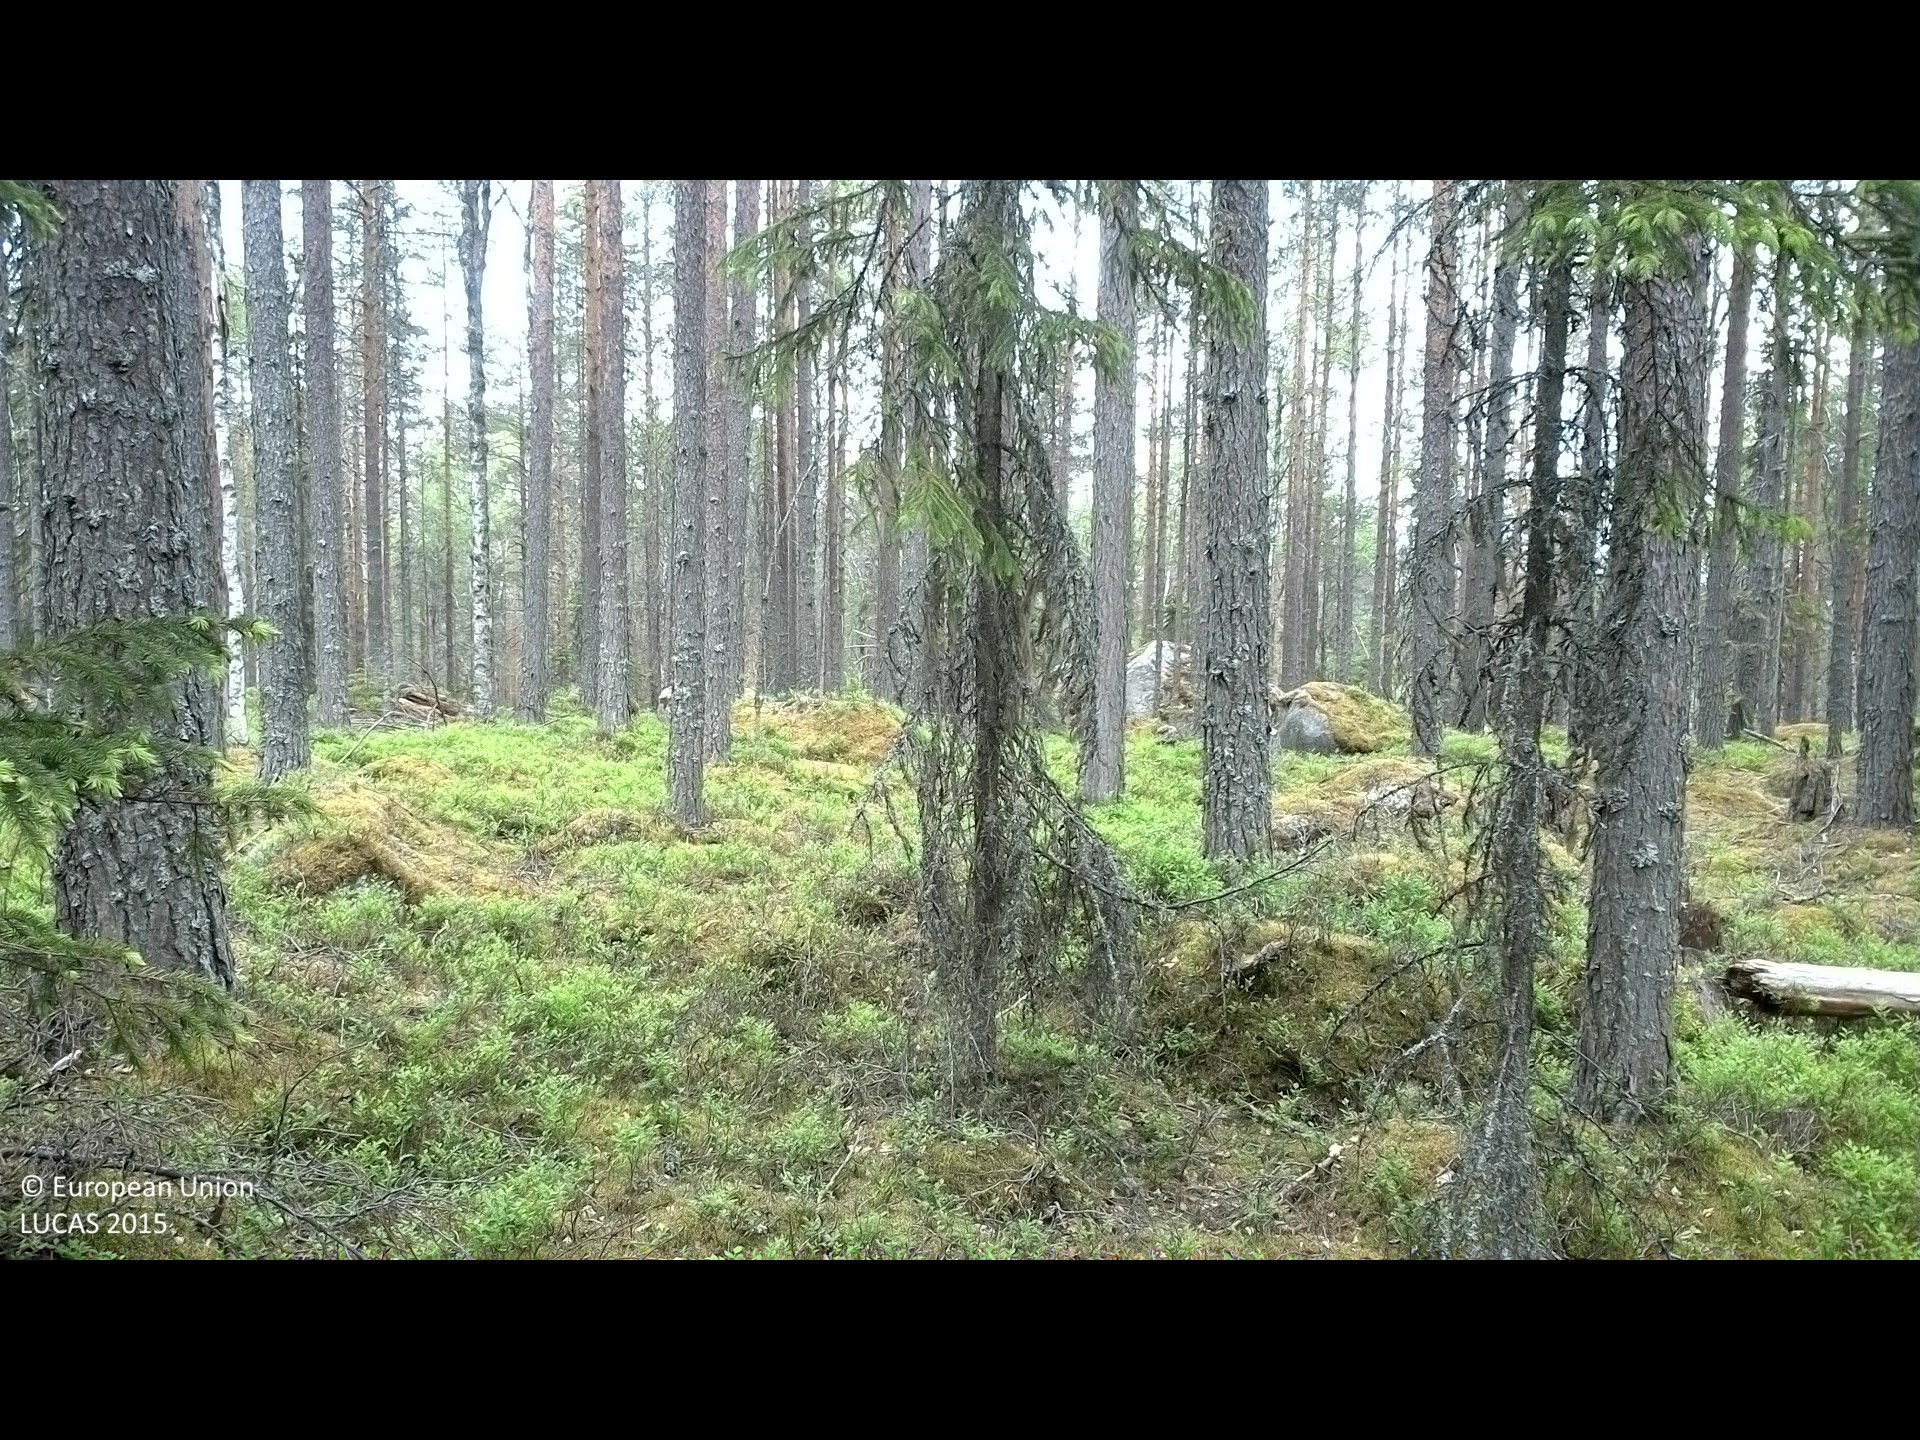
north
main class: Woodland
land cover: Pine dominated coniferous woodland
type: boreal forest
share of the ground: 25 - 50 %
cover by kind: coniferous forest trees 45 %, lichens and mosses 25 %, shrubs 20 %, broadleaved forest trees 10 %
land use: Forestry
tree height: > 5 m
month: June
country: SE
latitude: 61.9610
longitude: 16.1794
